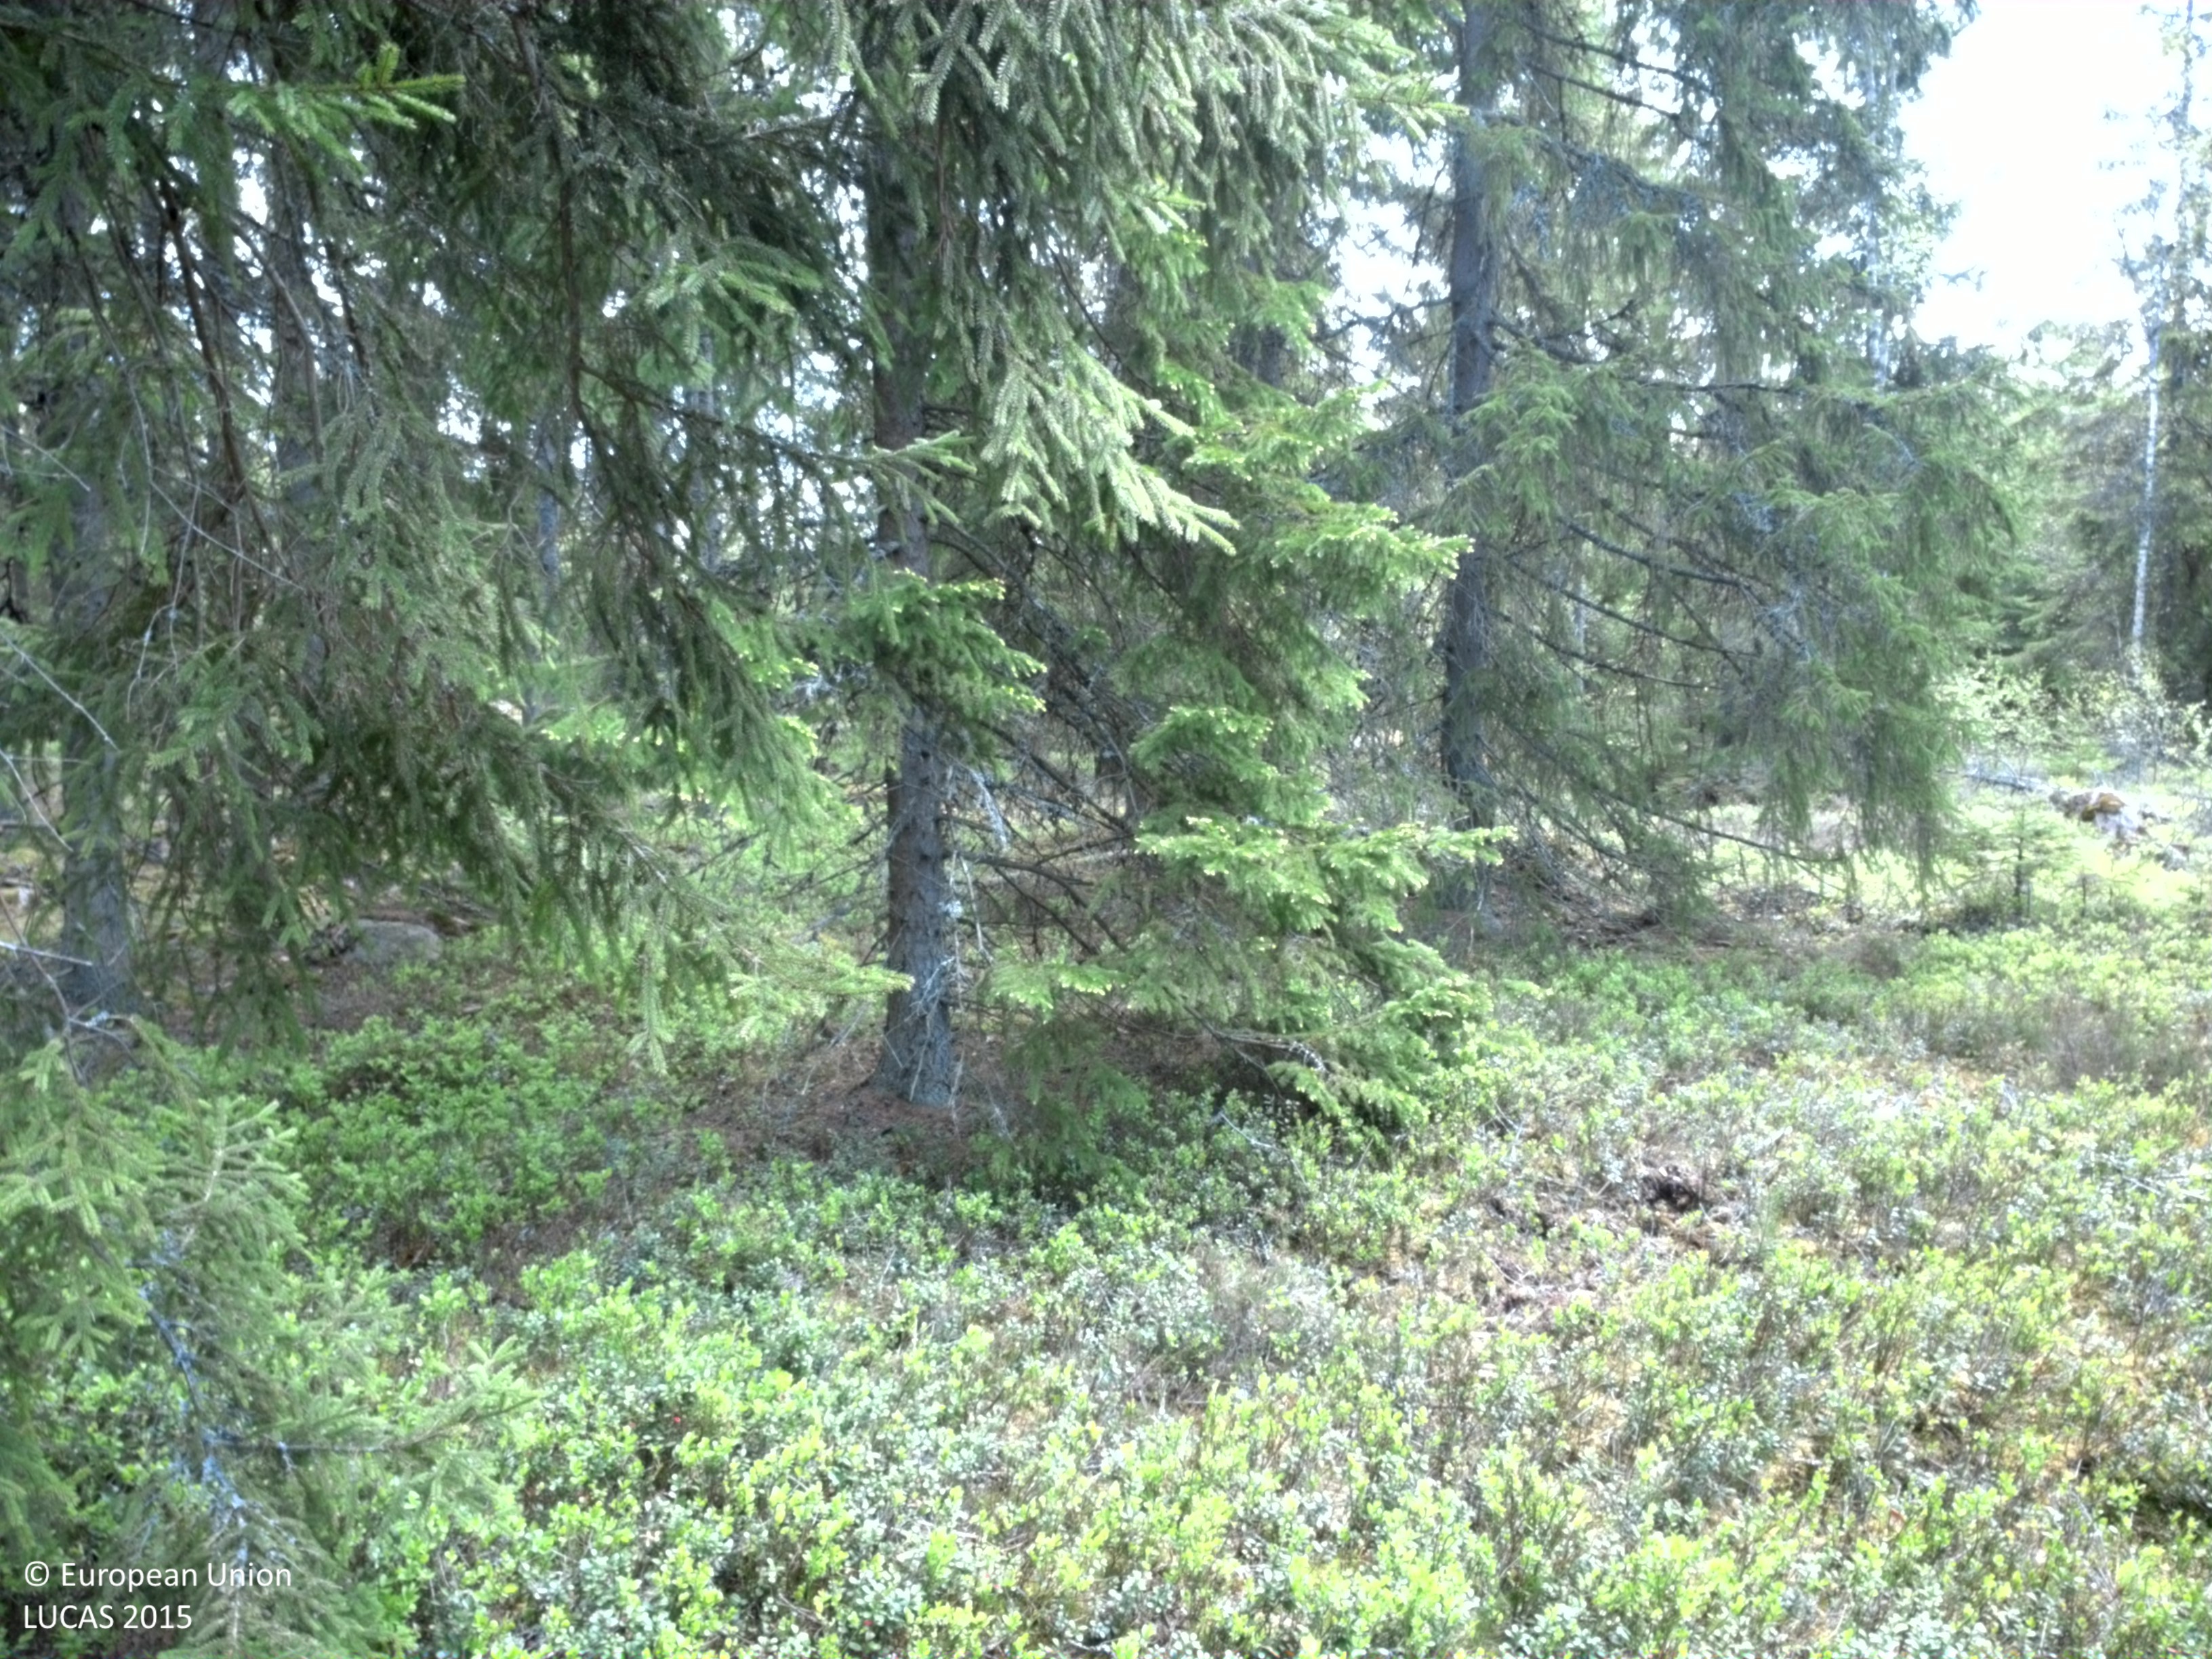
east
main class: Woodland
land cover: Spruce dominated coniferous woodland
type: boreal forest
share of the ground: 50 - 75 %
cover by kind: coniferous forest trees 60 %, shrubs 15 %, lichens and mosses 15 %, broadleaved forest trees 10 %
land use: Forestry
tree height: > 5 m
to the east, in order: Spruce dominated coniferous woodland; Spruce dominated mixed woodland
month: May
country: SE
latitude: 56.7818
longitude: 15.2845
